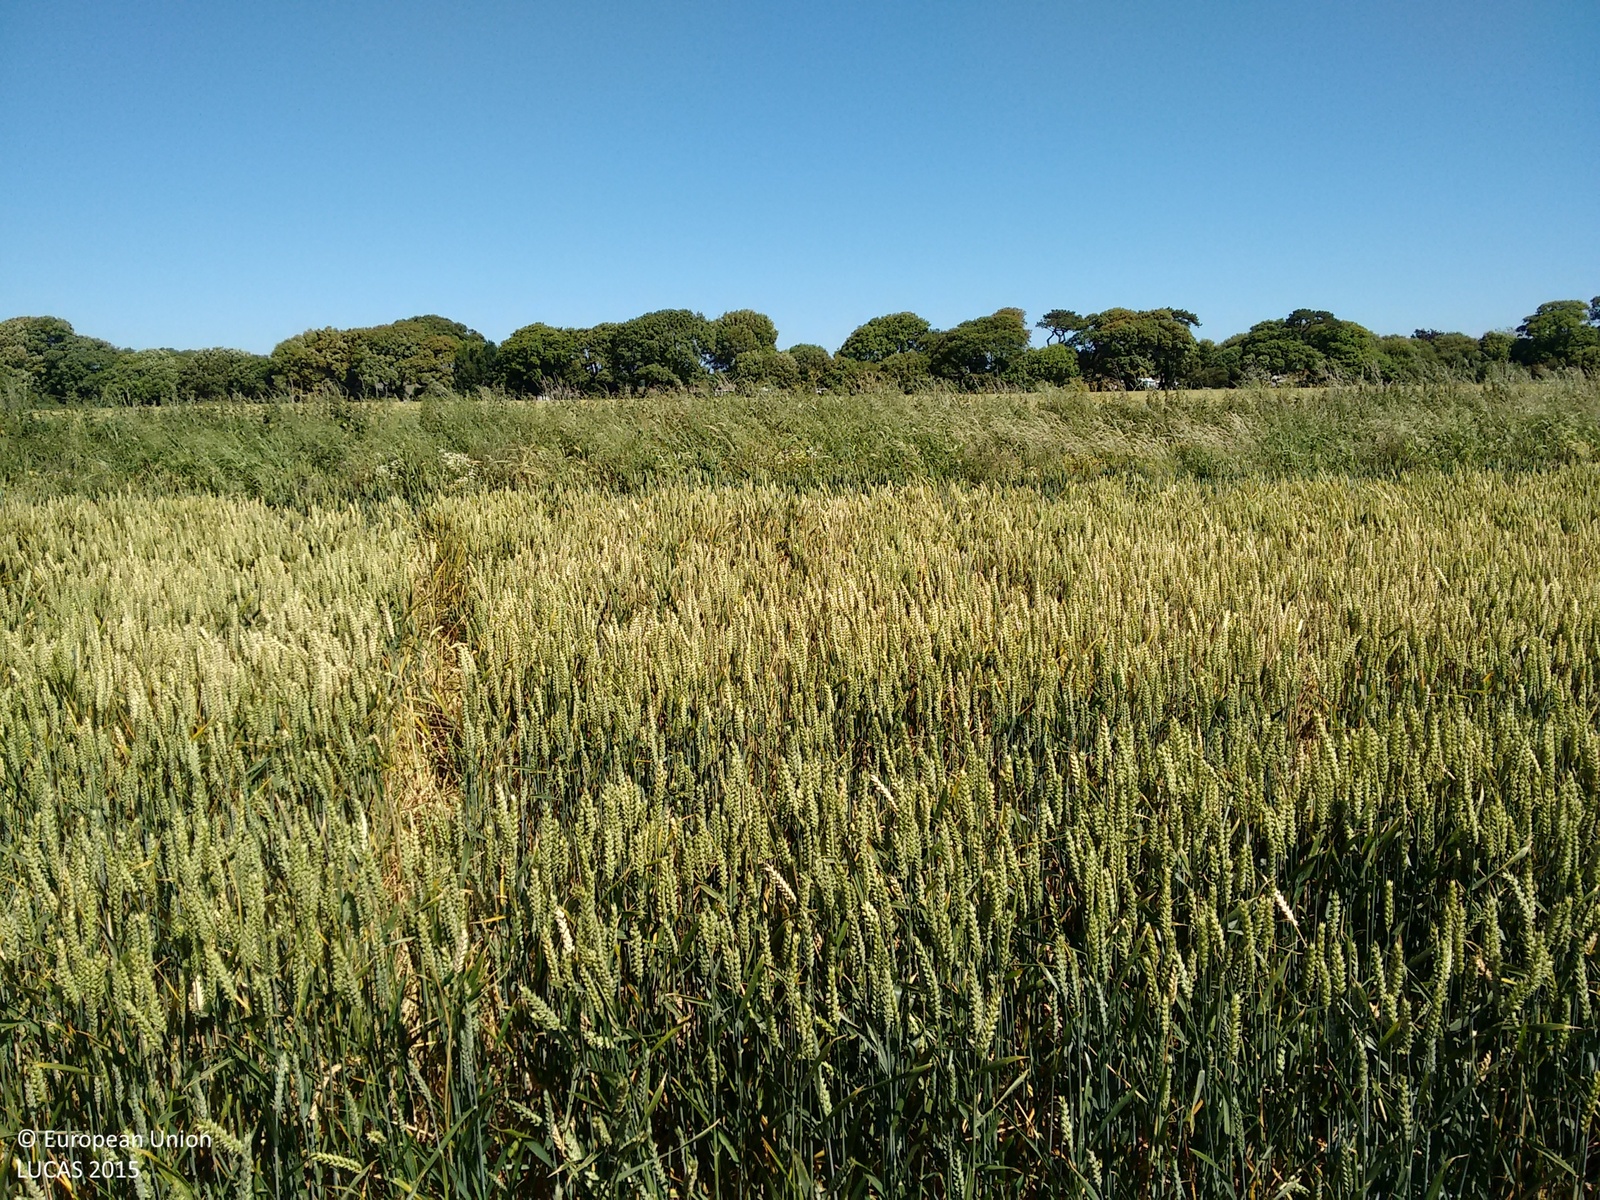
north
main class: Cropland
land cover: Common wheat
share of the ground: > 75 %
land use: Agriculture (excluding fallow land and kitchen gardens)
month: June
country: GB
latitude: 50.8098
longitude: -0.4400
